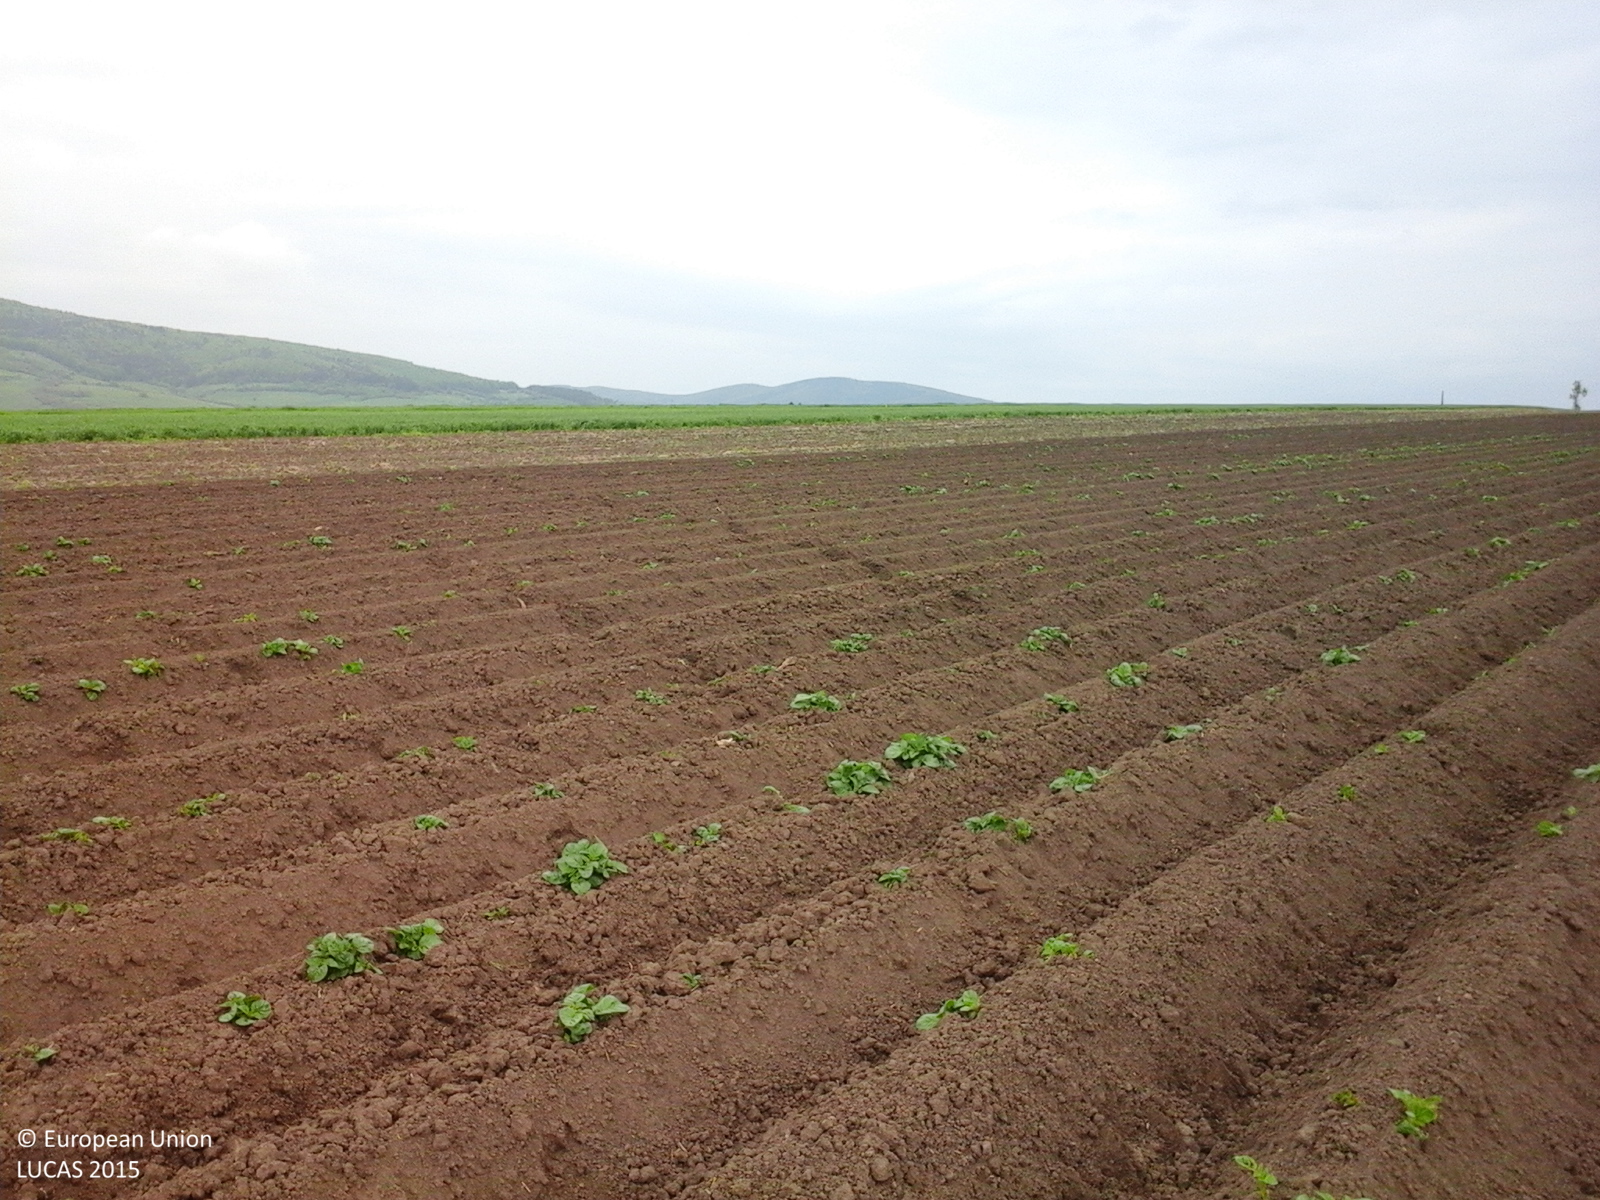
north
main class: Cropland
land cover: Potatoes
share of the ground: < 10 %
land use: Agriculture (excluding fallow land and kitchen gardens)
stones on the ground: < 10 %
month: May
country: RO
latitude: 46.0560
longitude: 26.1090
